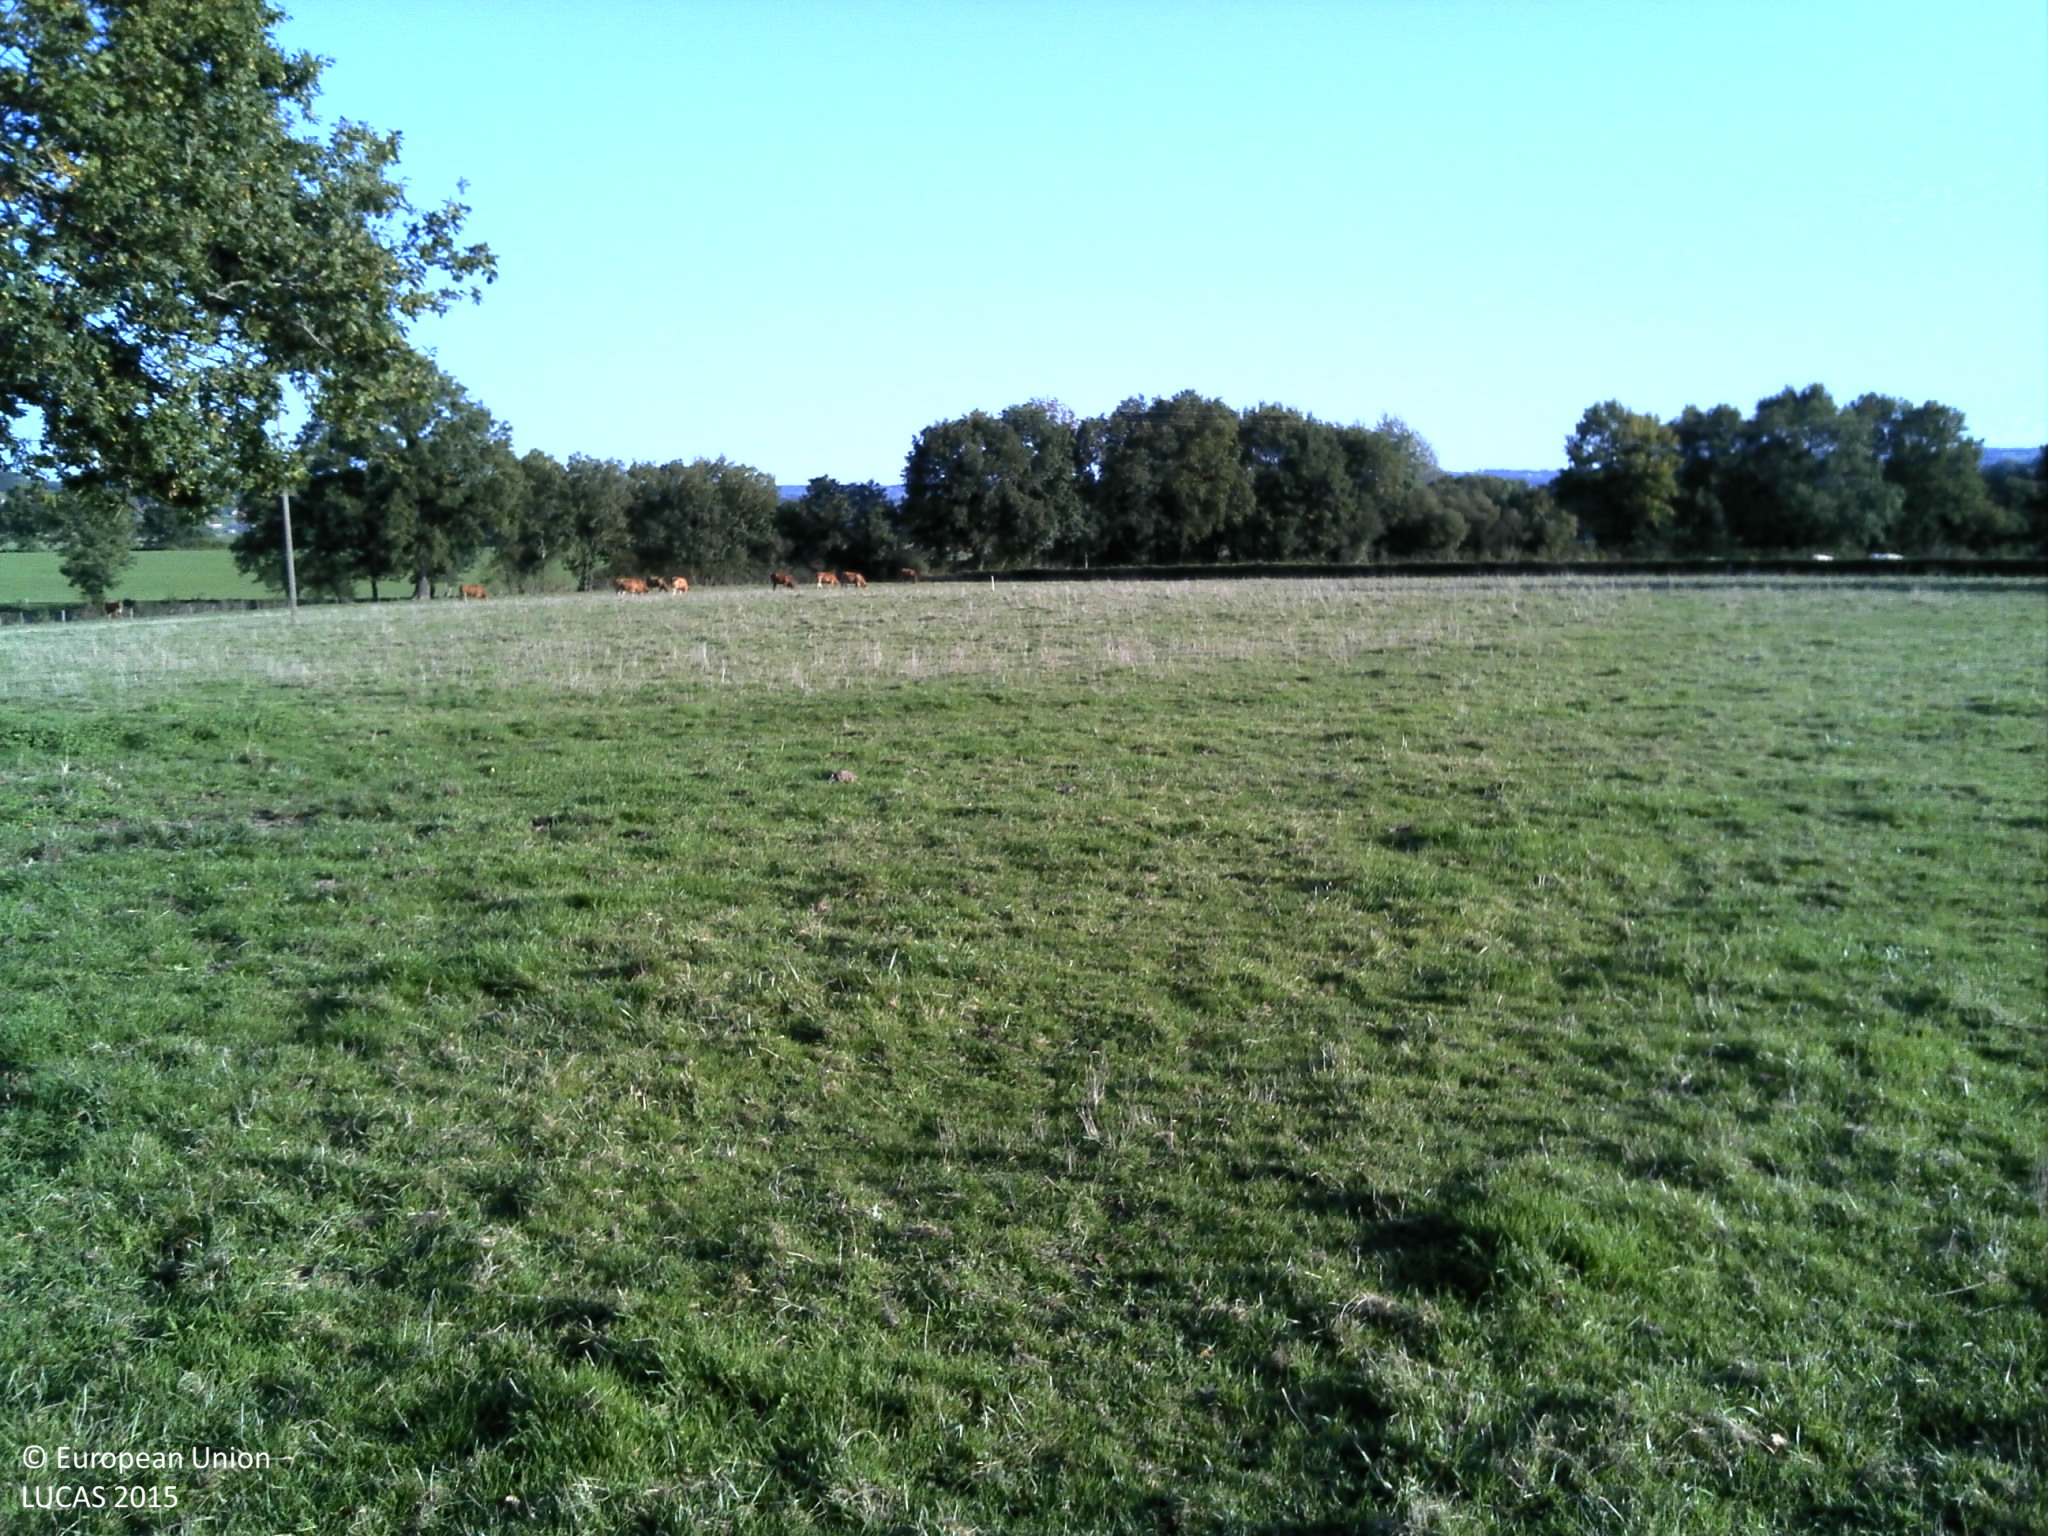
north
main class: Grassland
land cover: Grassland with sparse tree/shrub cover
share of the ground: > 75 %
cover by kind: herbaceous plants 95 %, broadleaved forest trees 5 %
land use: Agriculture (excluding fallow land and kitchen gardens)
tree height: > 5 m
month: September
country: FR
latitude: 46.9813
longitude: 4.4127
